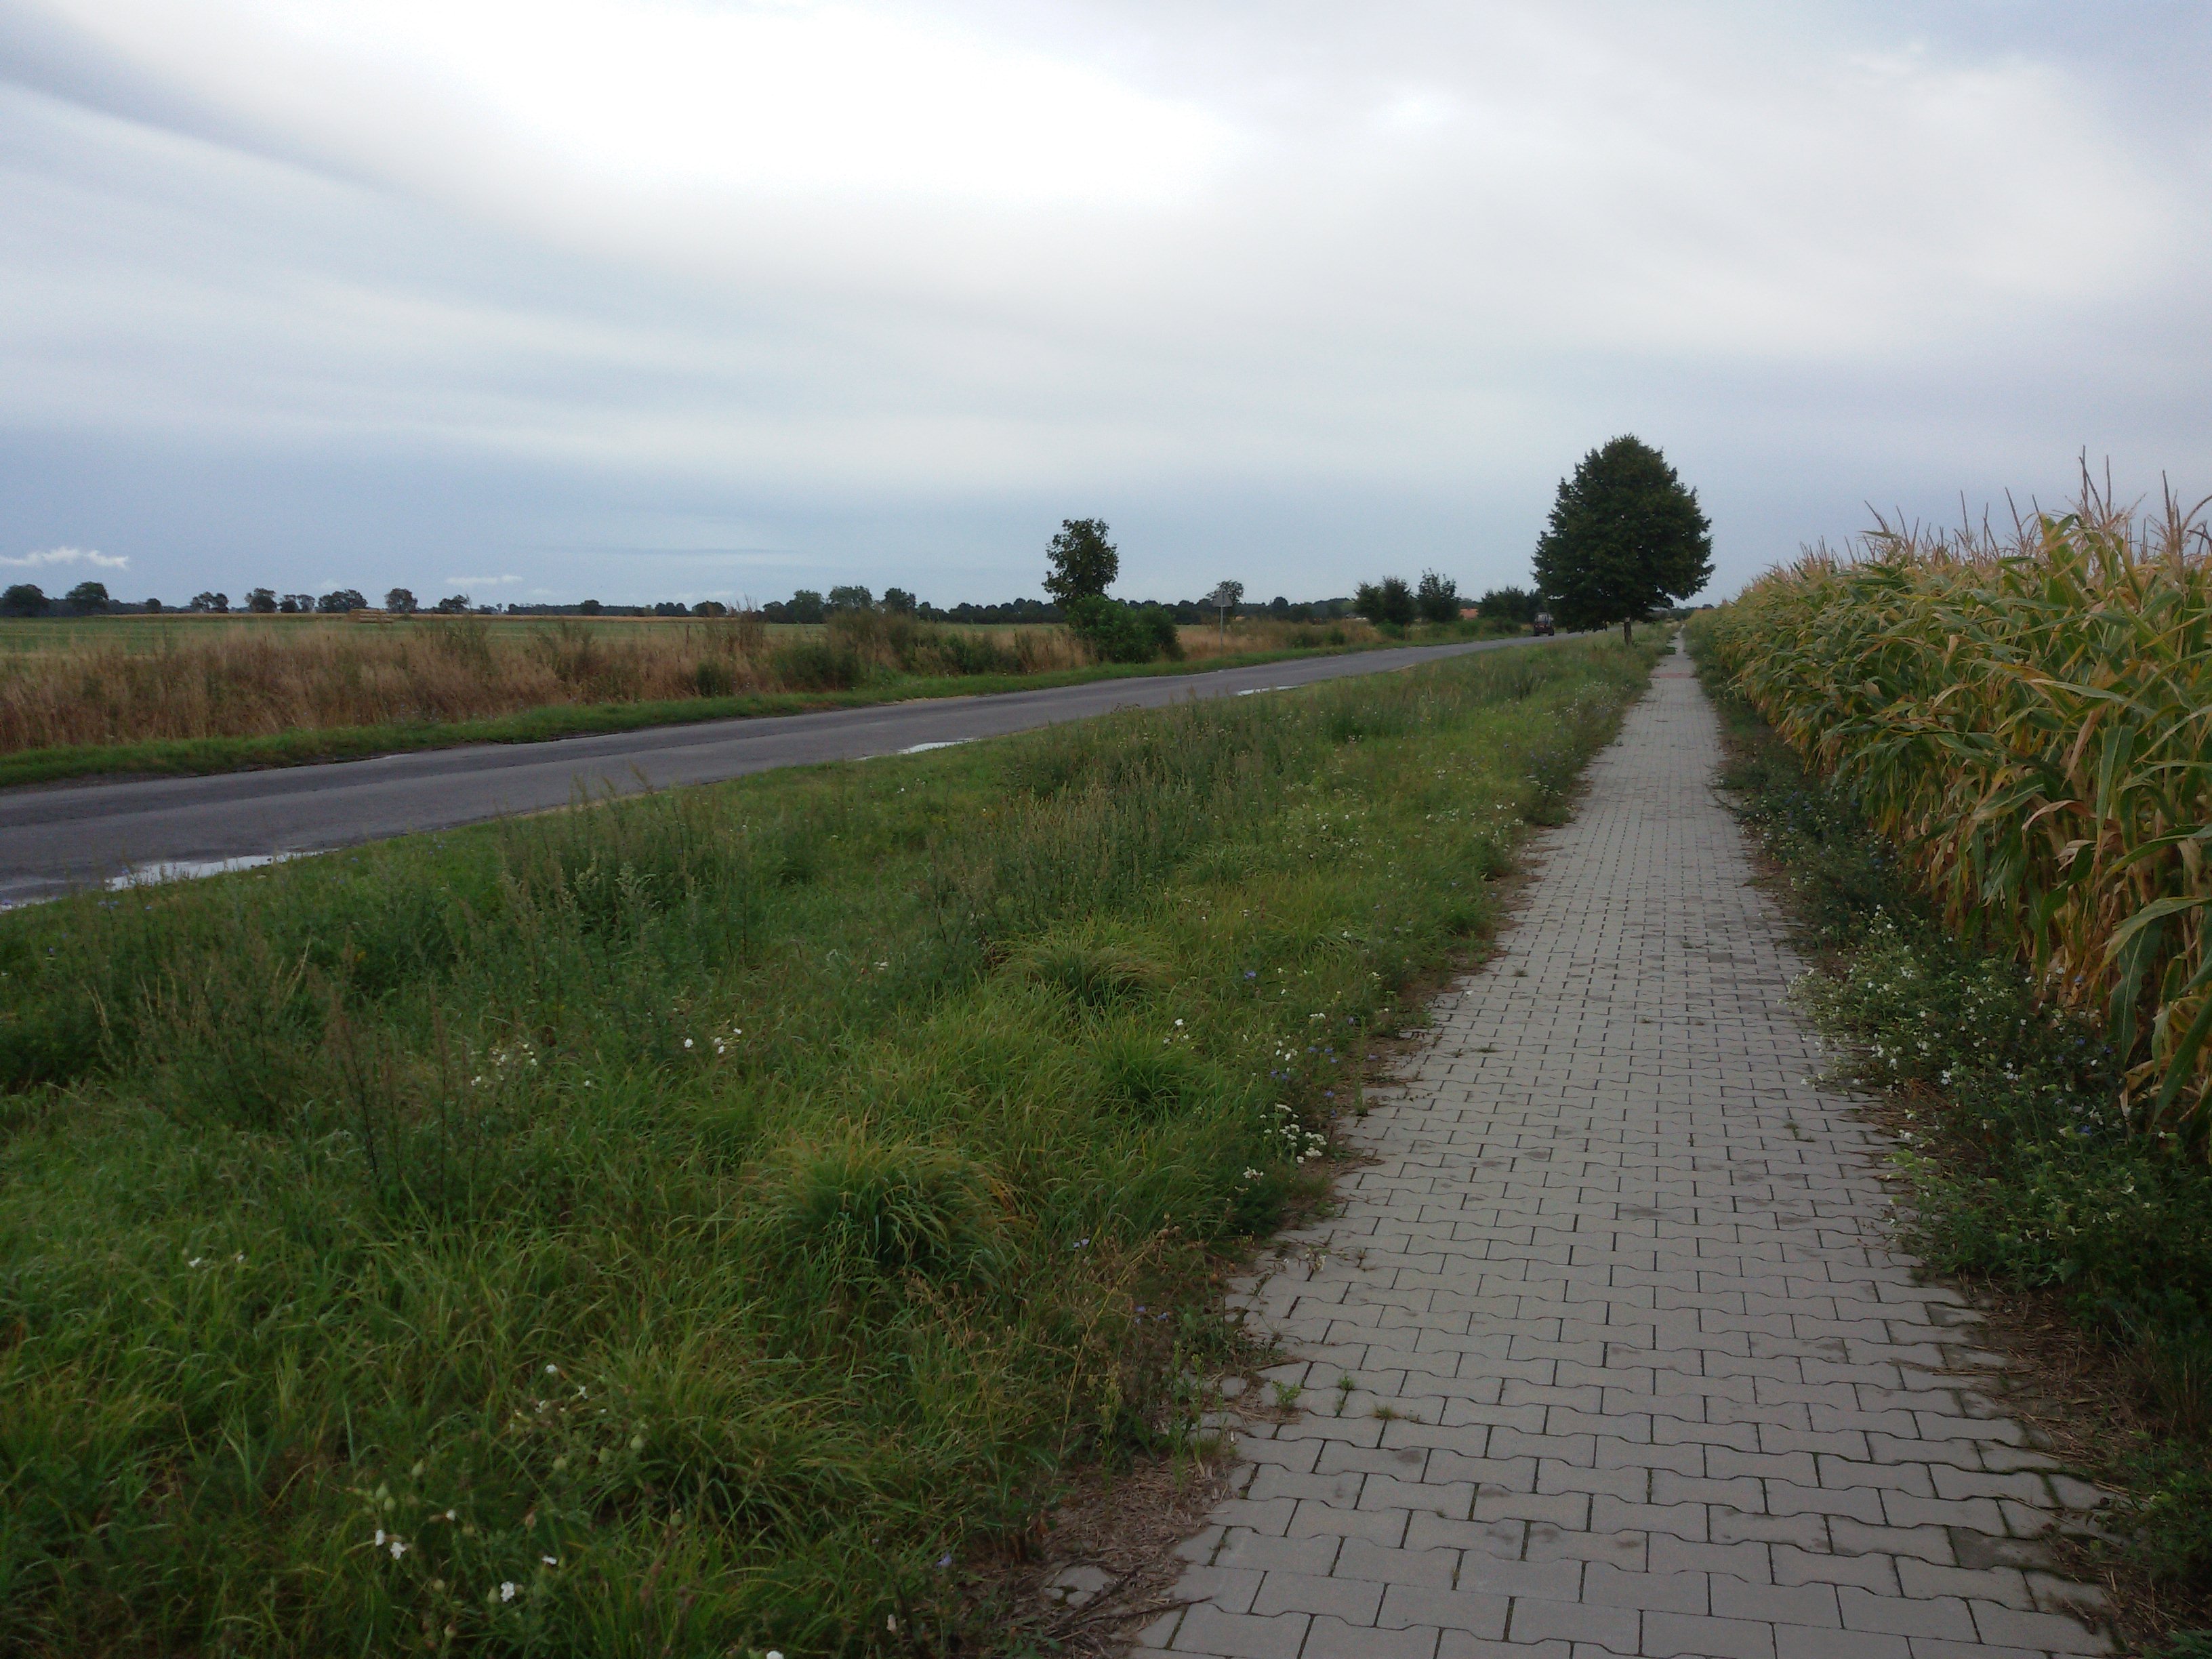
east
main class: Cropland
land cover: Maize
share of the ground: > 75 %
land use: Agriculture (excluding fallow land and kitchen gardens)
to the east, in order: Maize
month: August
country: PL
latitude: 51.8789
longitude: 17.9031
